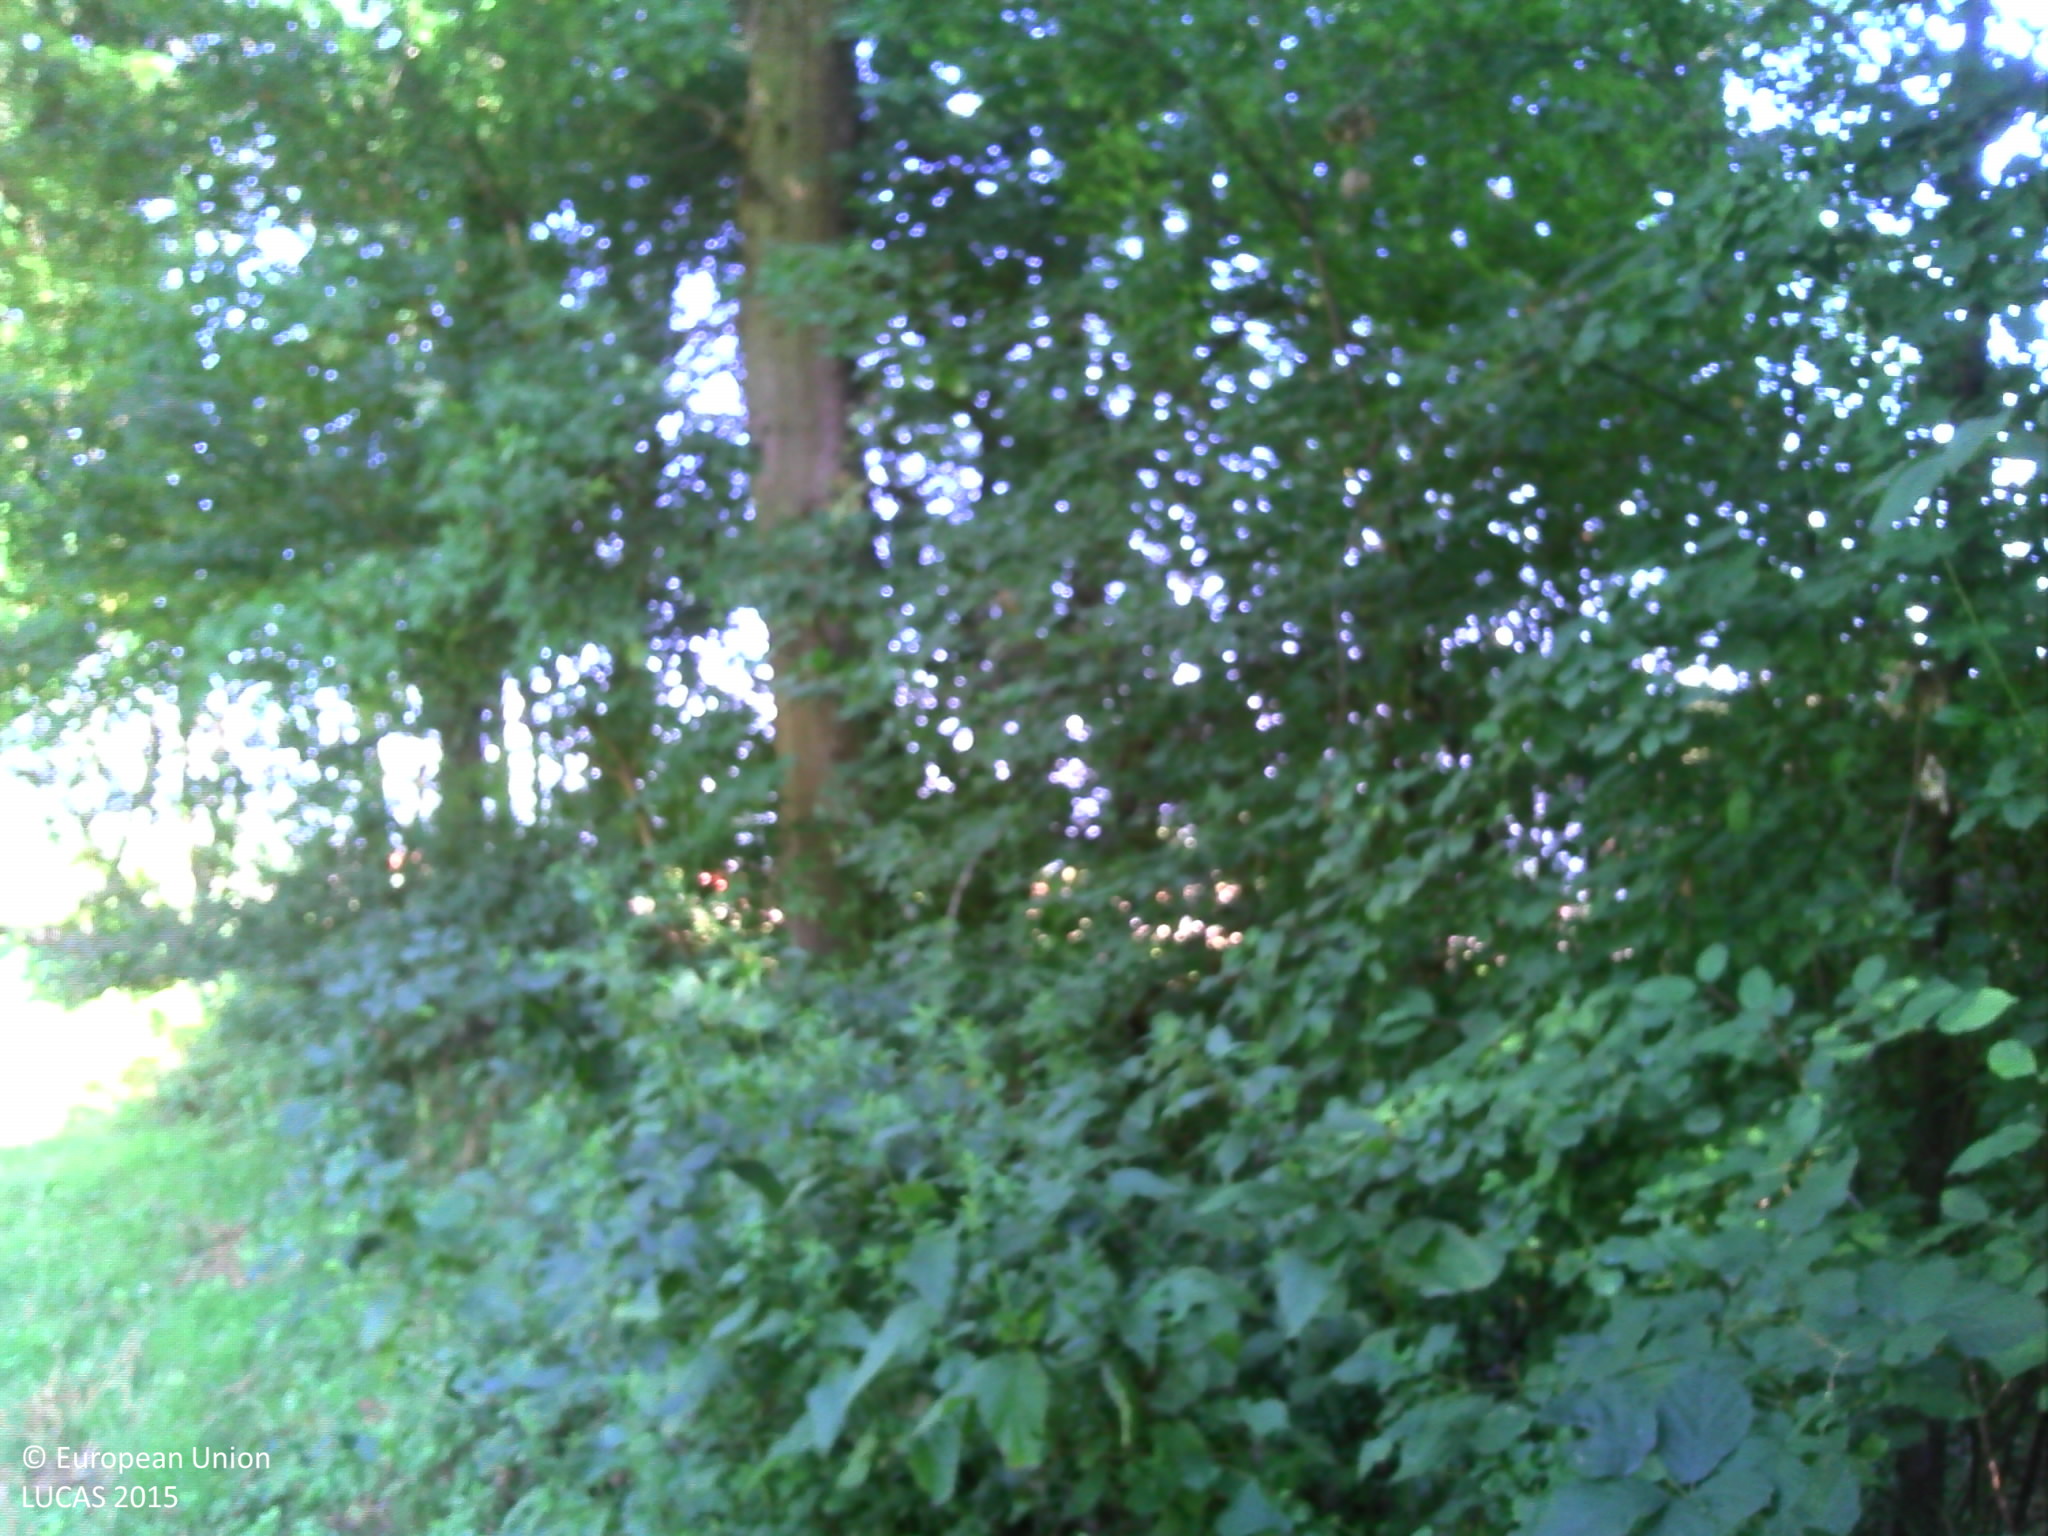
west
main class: Woodland
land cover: Broadleaved woodland
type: mesophytic deciduous forest
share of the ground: > 75 %
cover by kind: broadleaved forest trees 95 %, herbaceous plants 5 %
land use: Semi-natural and natural areas not in use
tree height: > 5 m
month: August
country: FR
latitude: 48.1564
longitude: 7.3797
